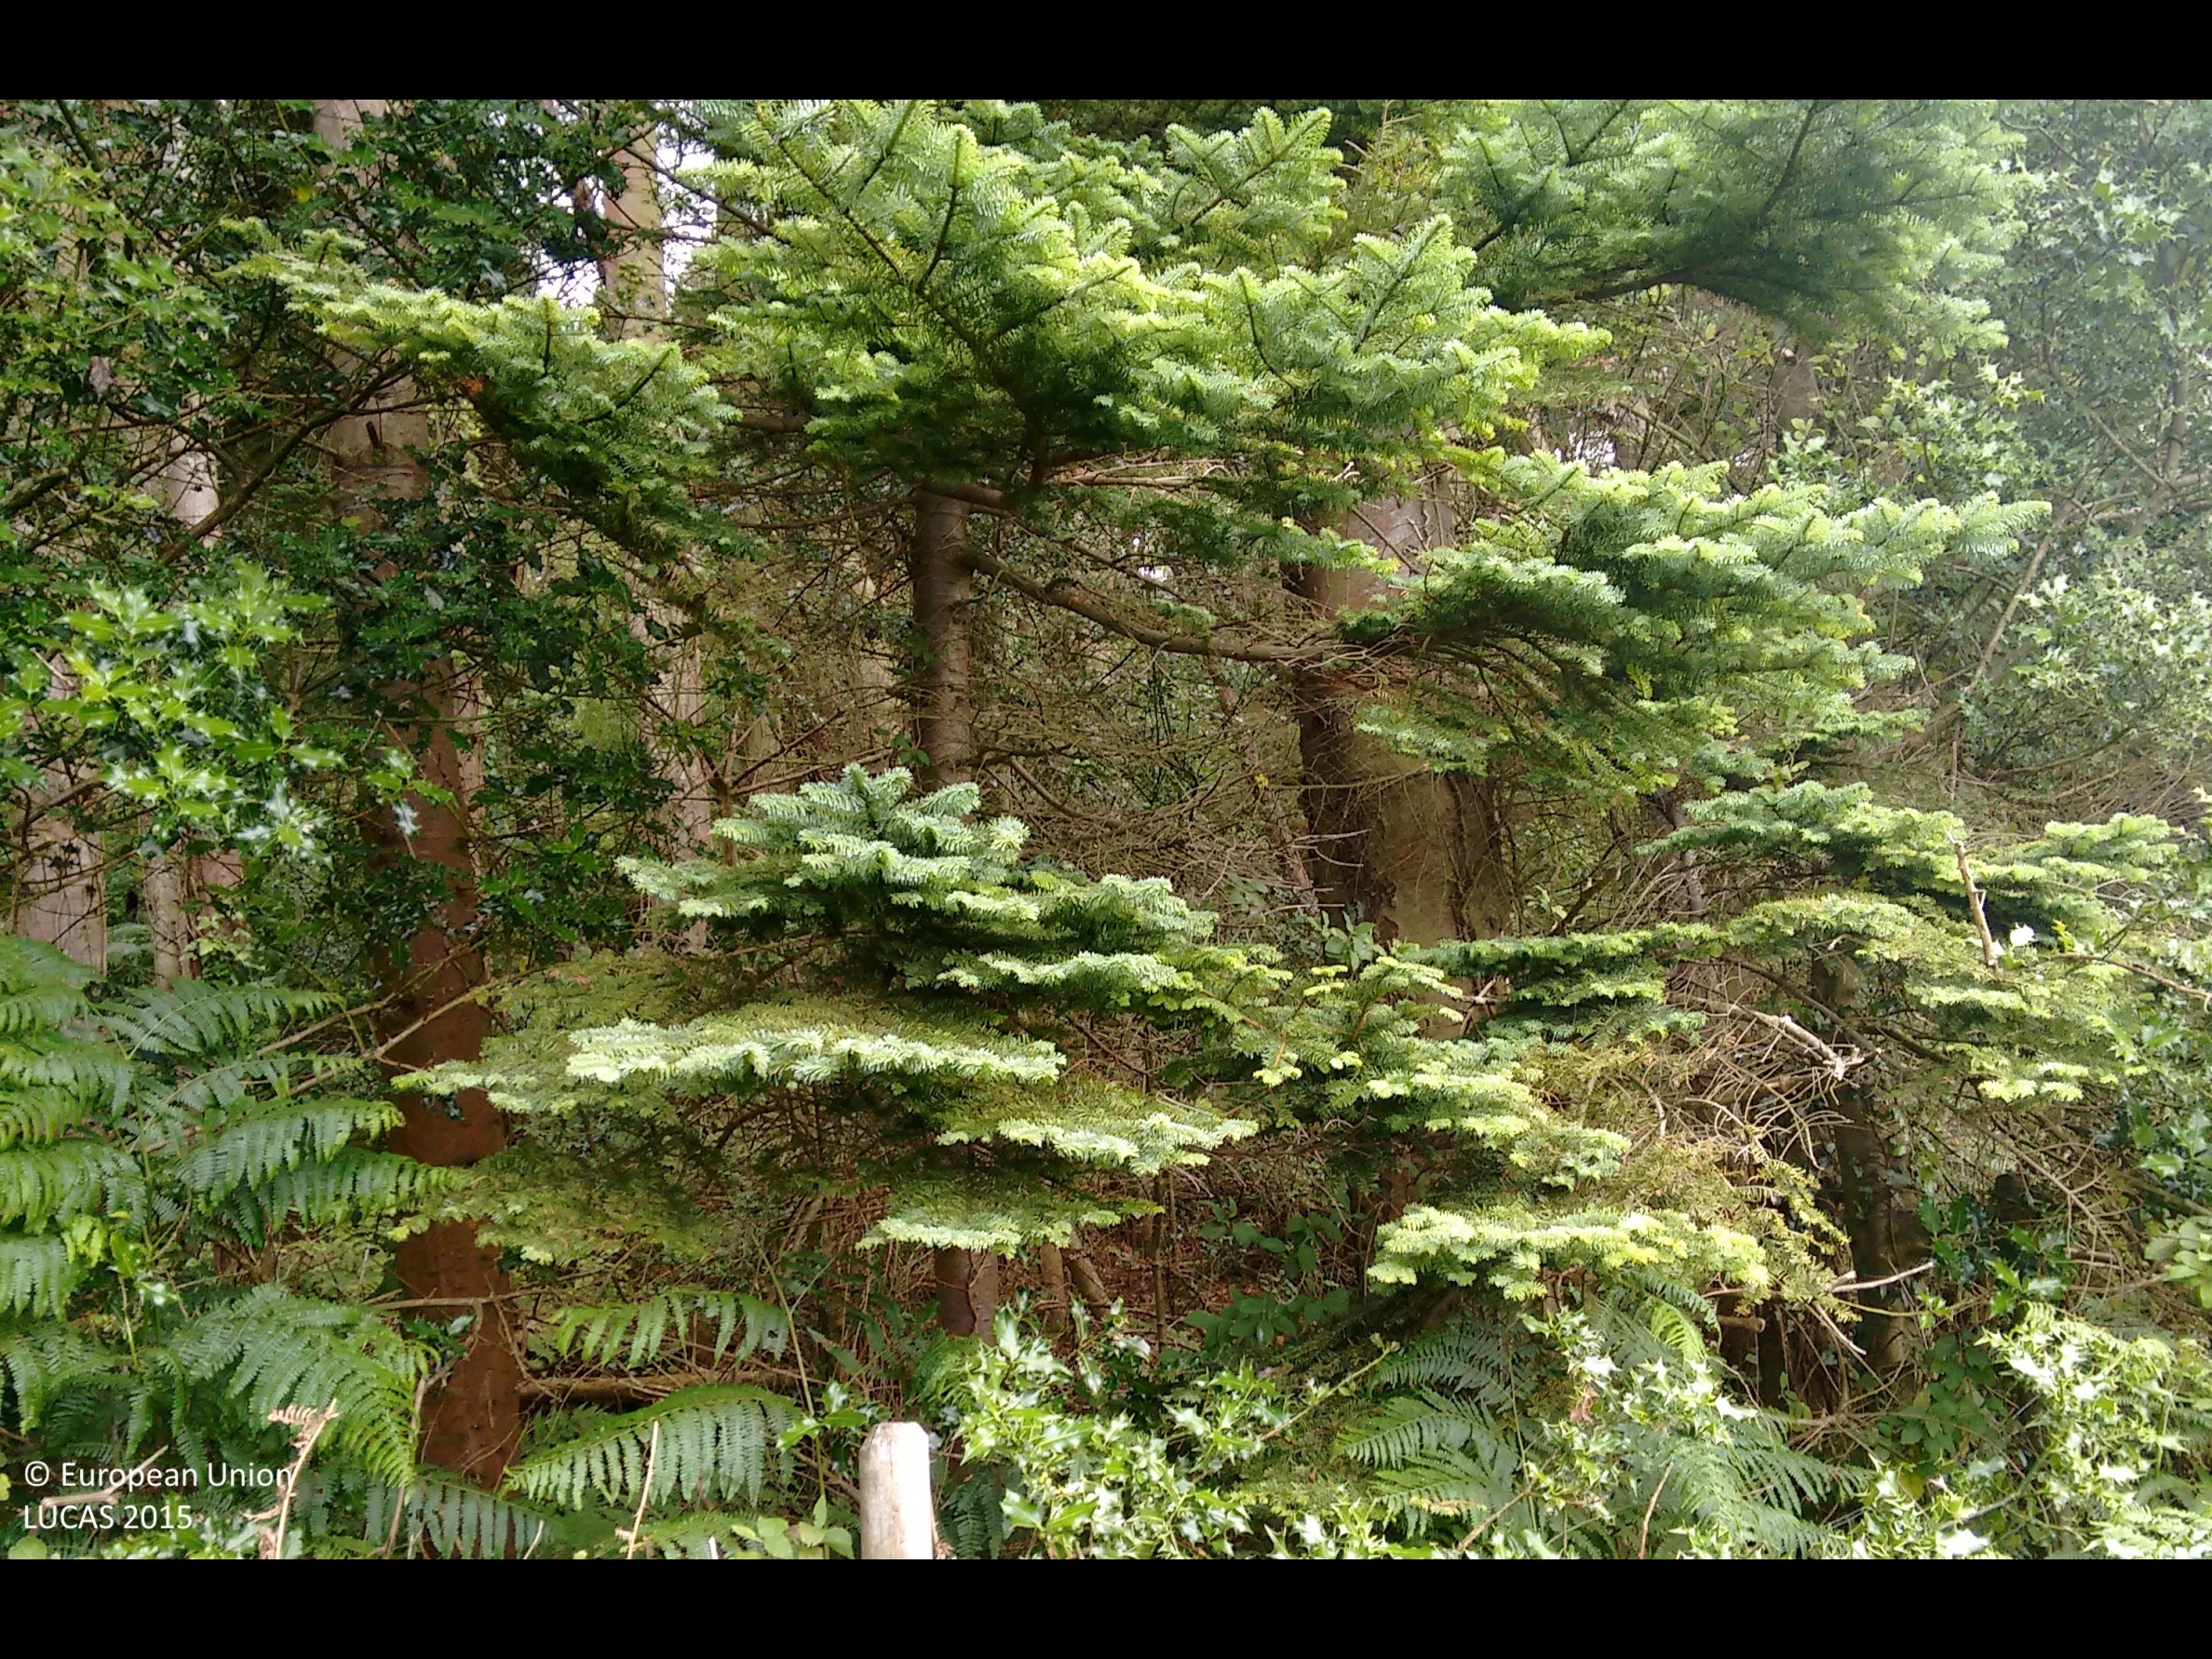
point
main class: Woodland
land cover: Other coniferous woodland
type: exotic forest
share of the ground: > 75 %
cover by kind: coniferous forest trees 100 %
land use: Forestry
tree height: > 5 m
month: August
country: GB
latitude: 53.2919
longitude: -4.1849
